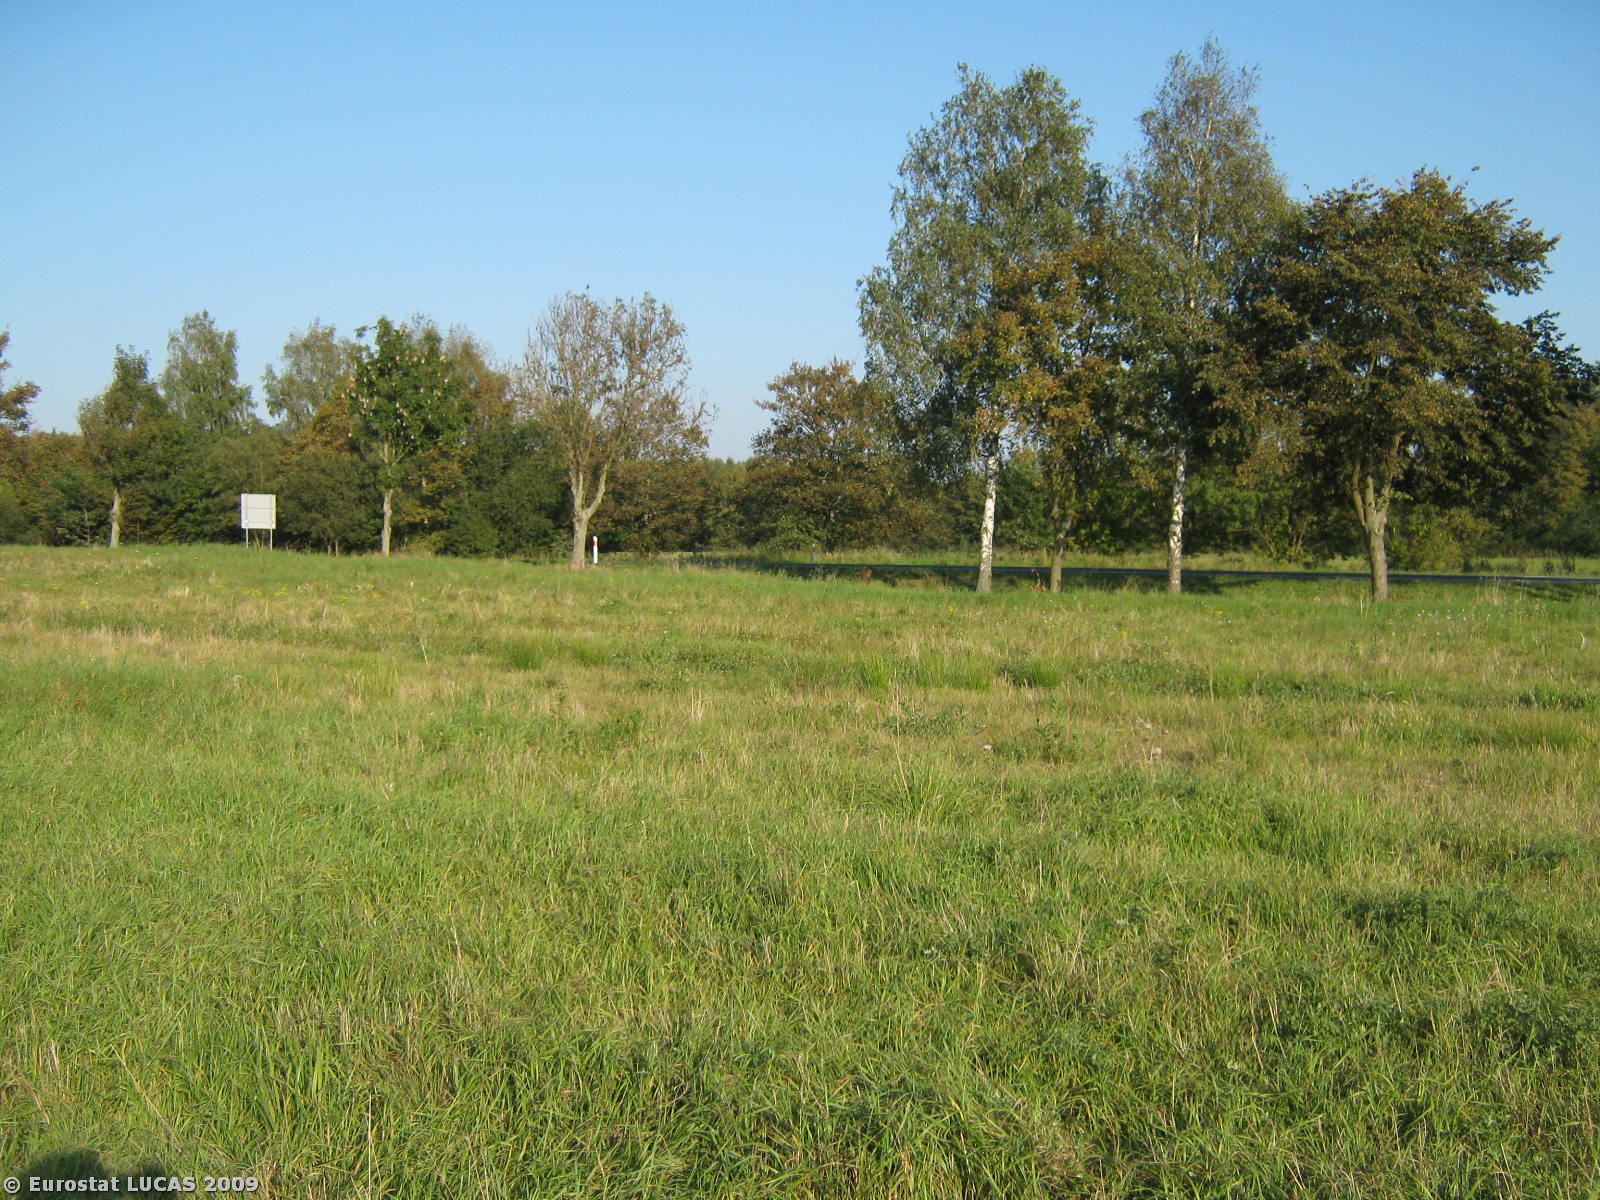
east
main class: Grassland
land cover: Grassland without tree/shrub cover
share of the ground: > 75 %
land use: Agriculture (excluding fallow land and kitchen gardens)
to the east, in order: Grassland without tree/shrub cover; Lines of trees; Paved roads, cycling and walking lanes; Lines of trees; Grassland without tree/shrub cover
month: September
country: PL
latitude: 54.0833
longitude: 15.9812
